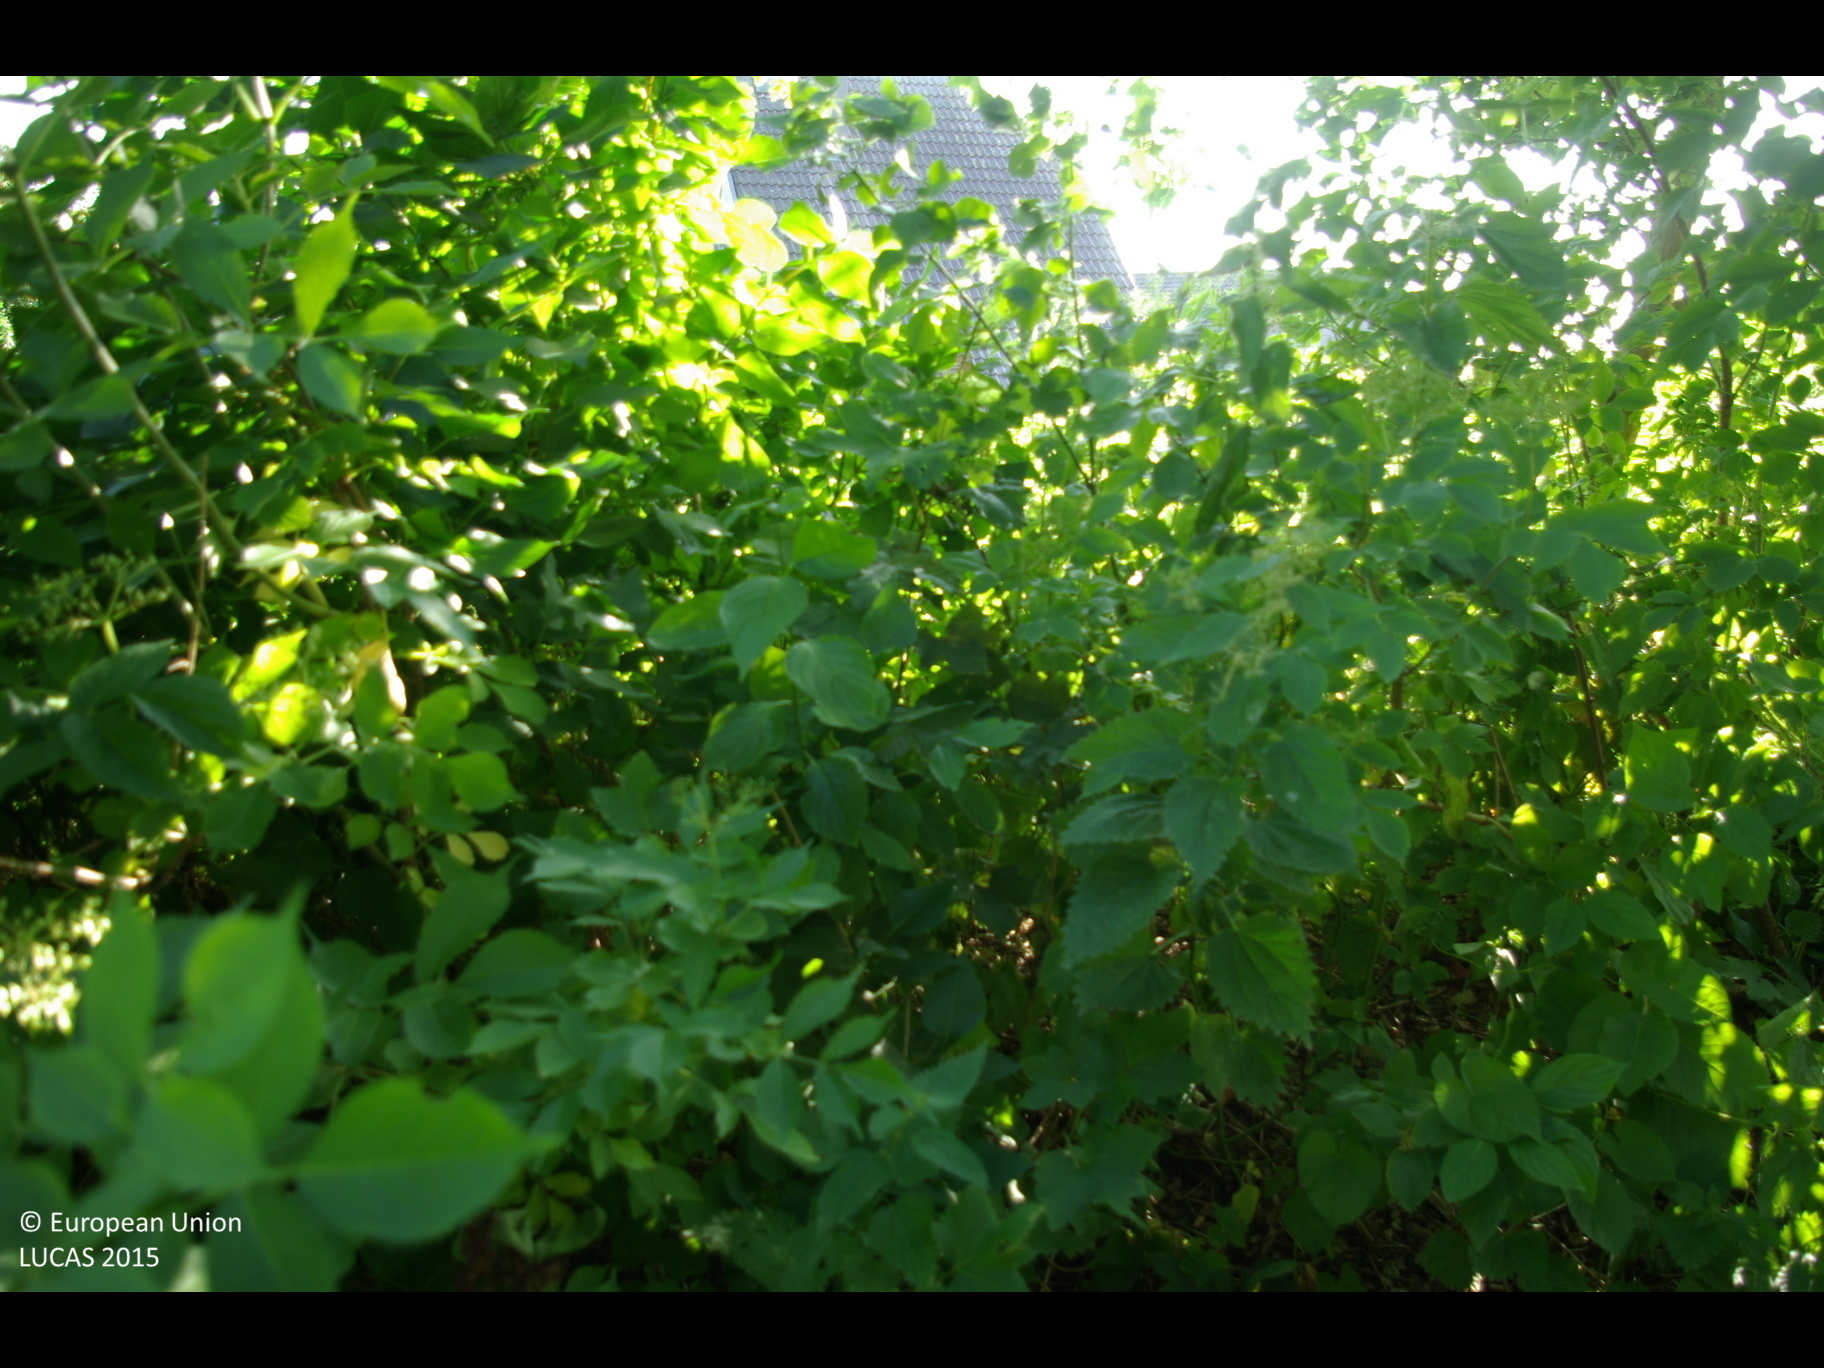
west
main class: Grassland
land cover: Grassland without tree/shrub cover
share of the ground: > 75 %
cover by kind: herbaceous plants 100 %
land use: Residential
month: July
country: DE
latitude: 54.7138
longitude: 9.8604
